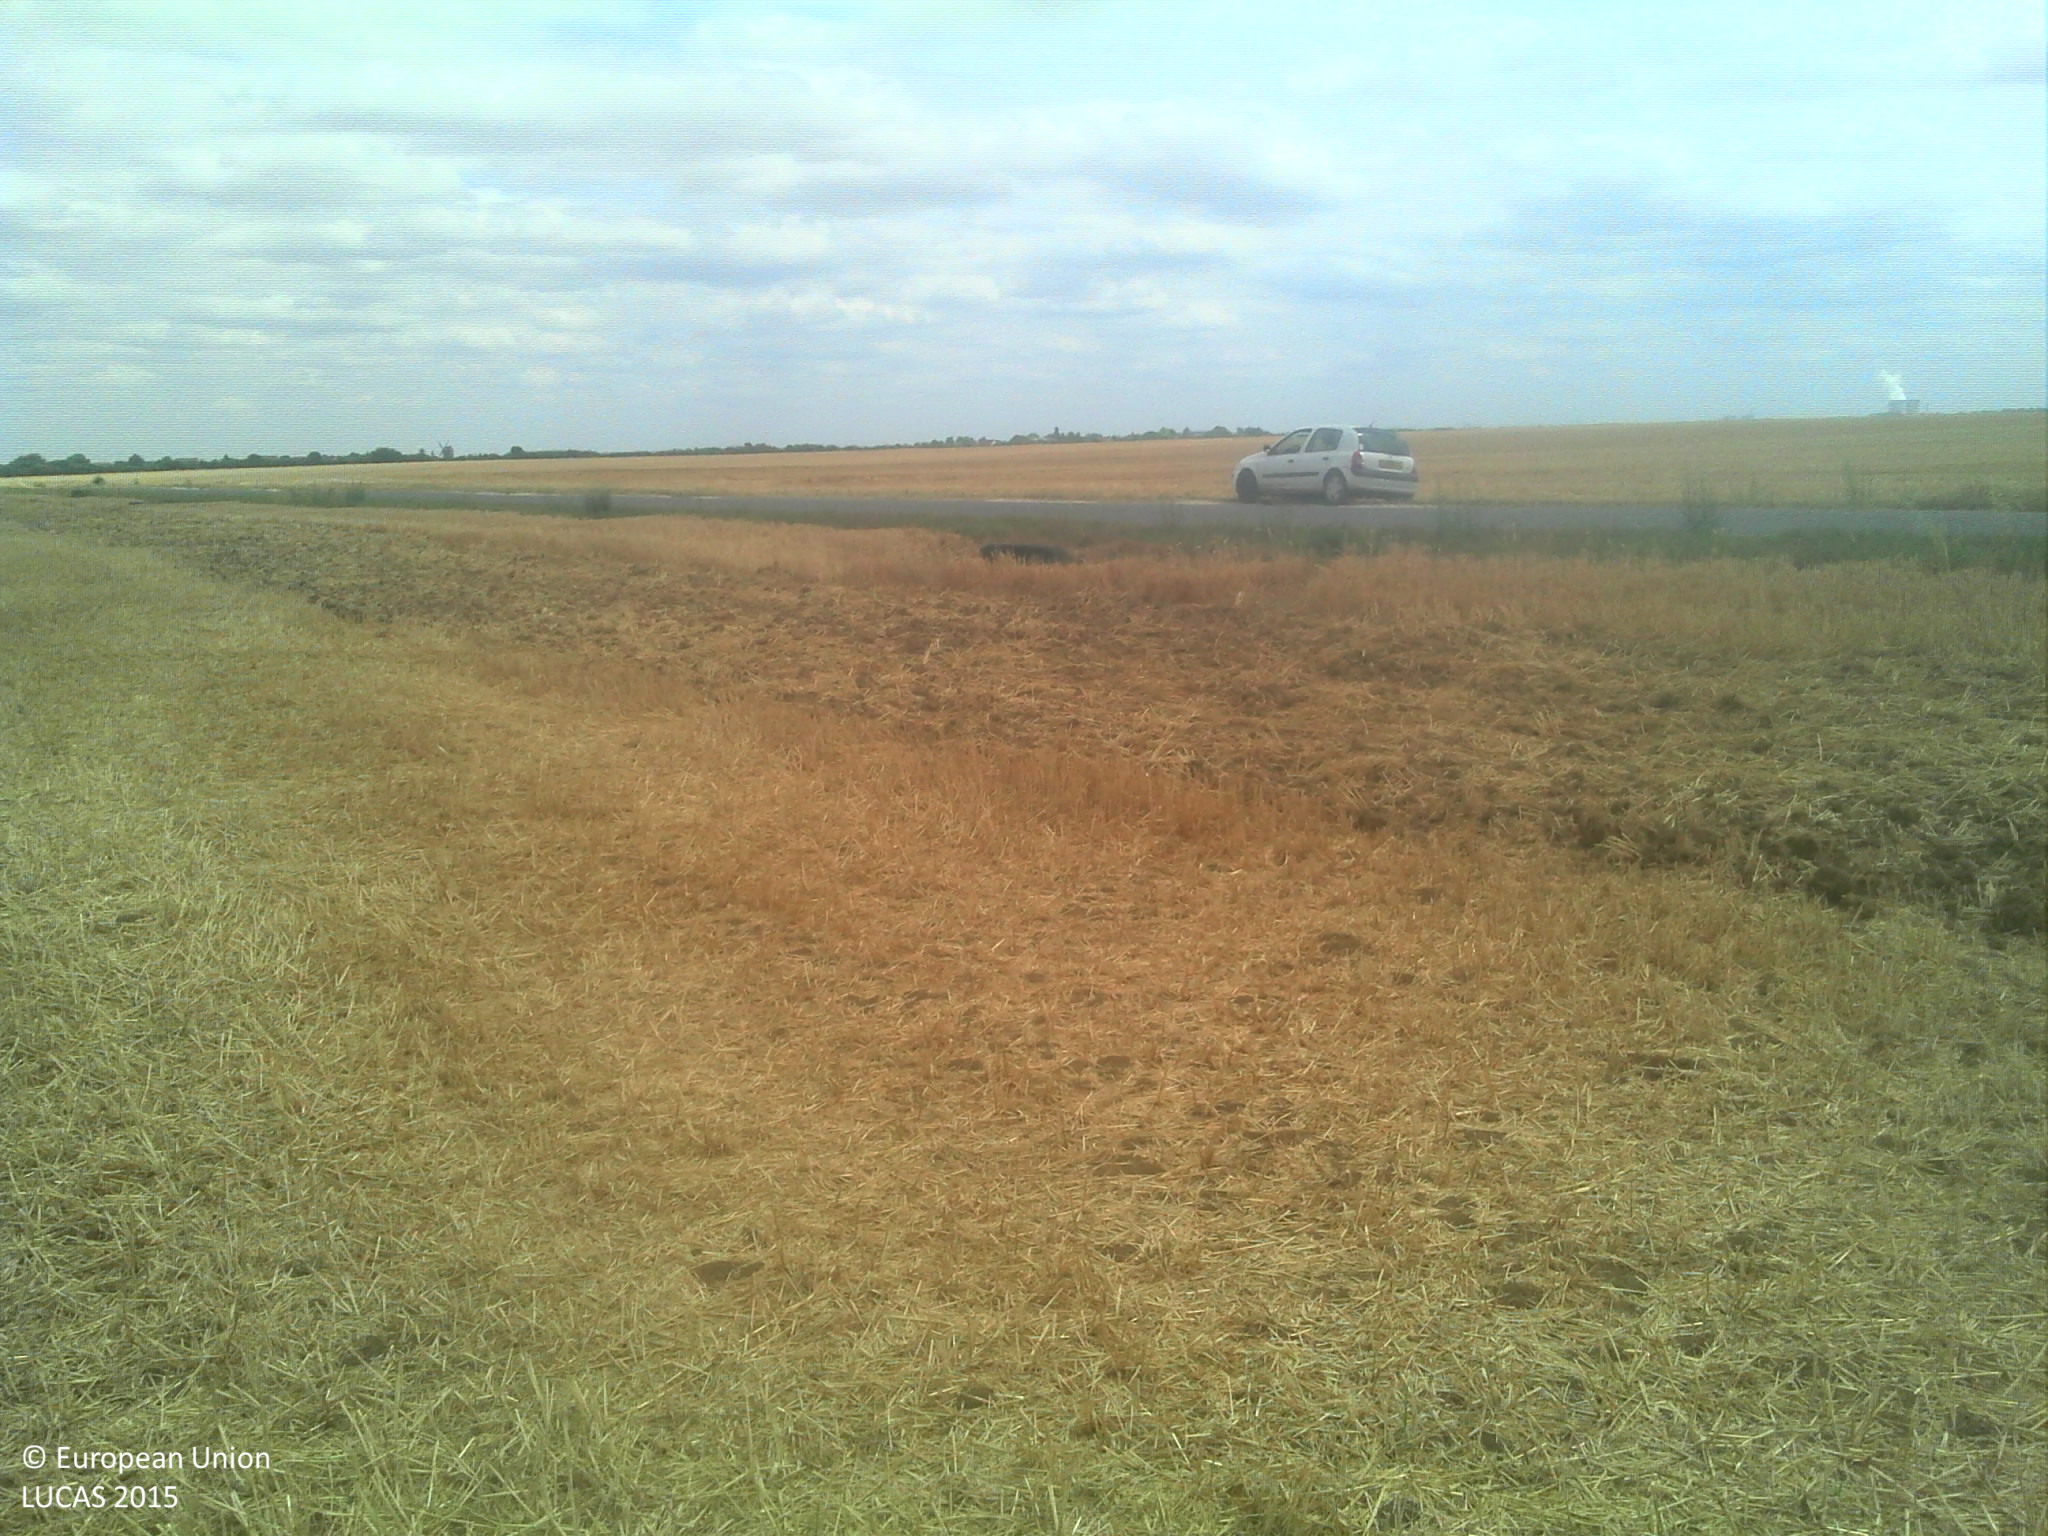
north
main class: Cropland
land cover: Common wheat
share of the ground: > 75 %
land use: Agriculture (excluding fallow land and kitchen gardens)
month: July
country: FR
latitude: 47.7629
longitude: 1.4327
